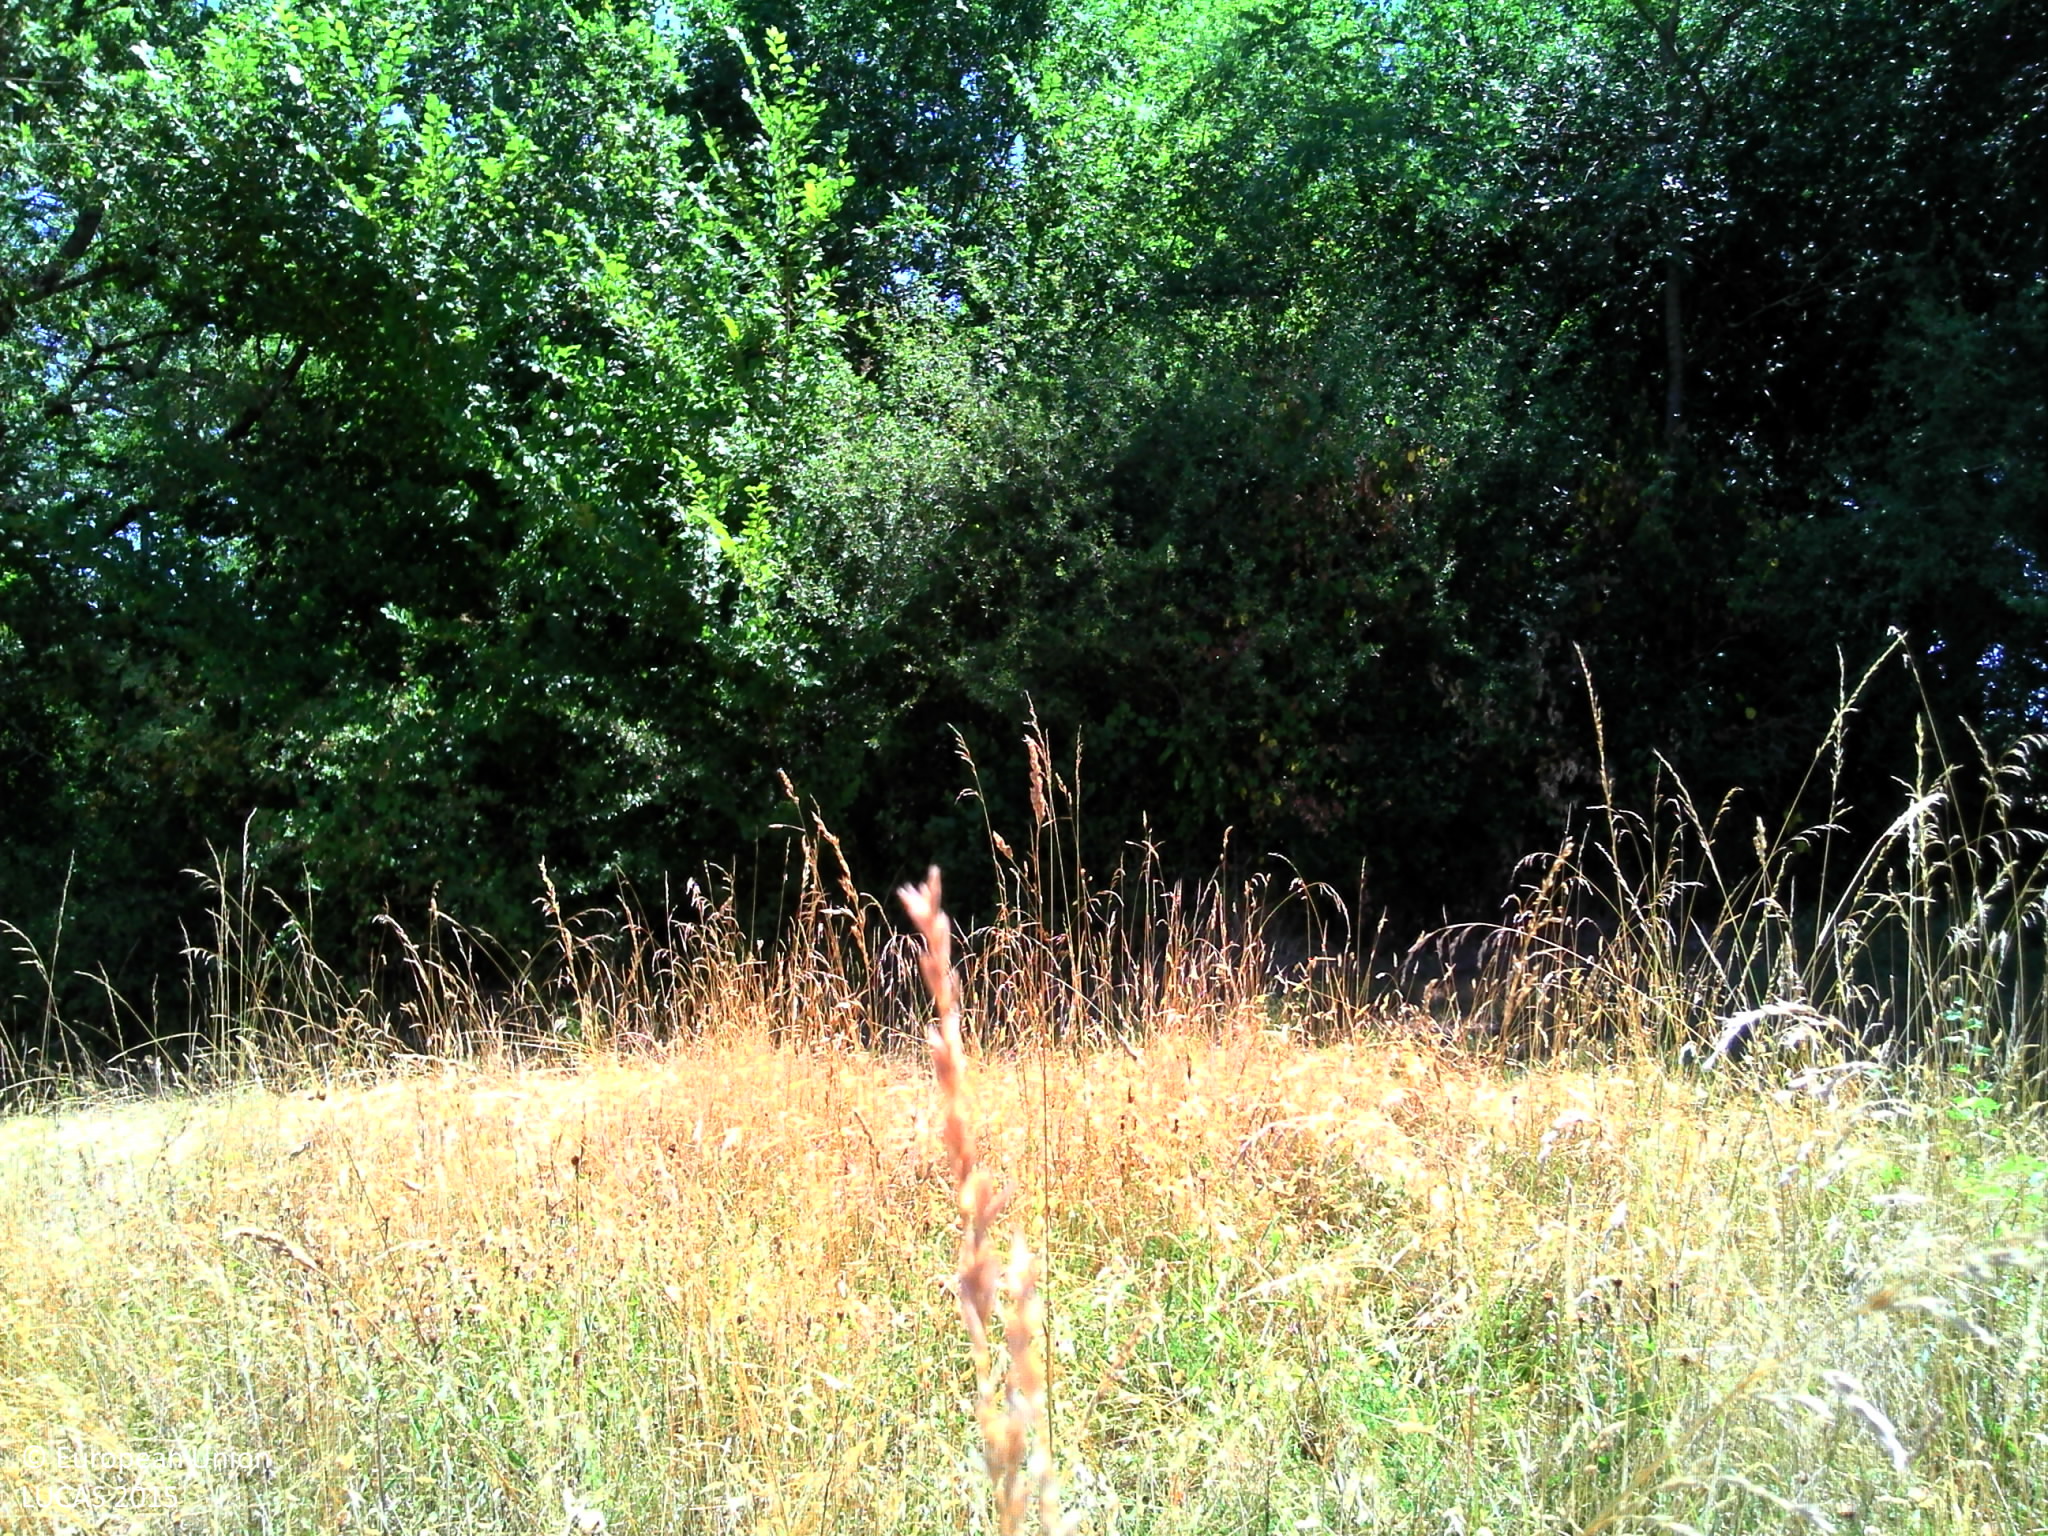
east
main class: Grassland
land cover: Grassland without tree/shrub cover
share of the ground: > 75 %
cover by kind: herbaceous plants 100 %
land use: Agriculture (excluding fallow land and kitchen gardens)
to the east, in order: Grassland without tree/shrub cover; Electric lines; Abandoned hedges; Tracks; Abandoned hedges; Grassland without tree/shrub cover; Broadleaved woodland; Tracks; Grassland without tree/shrub cover
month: July
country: FR
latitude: 44.8810
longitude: 0.5591
